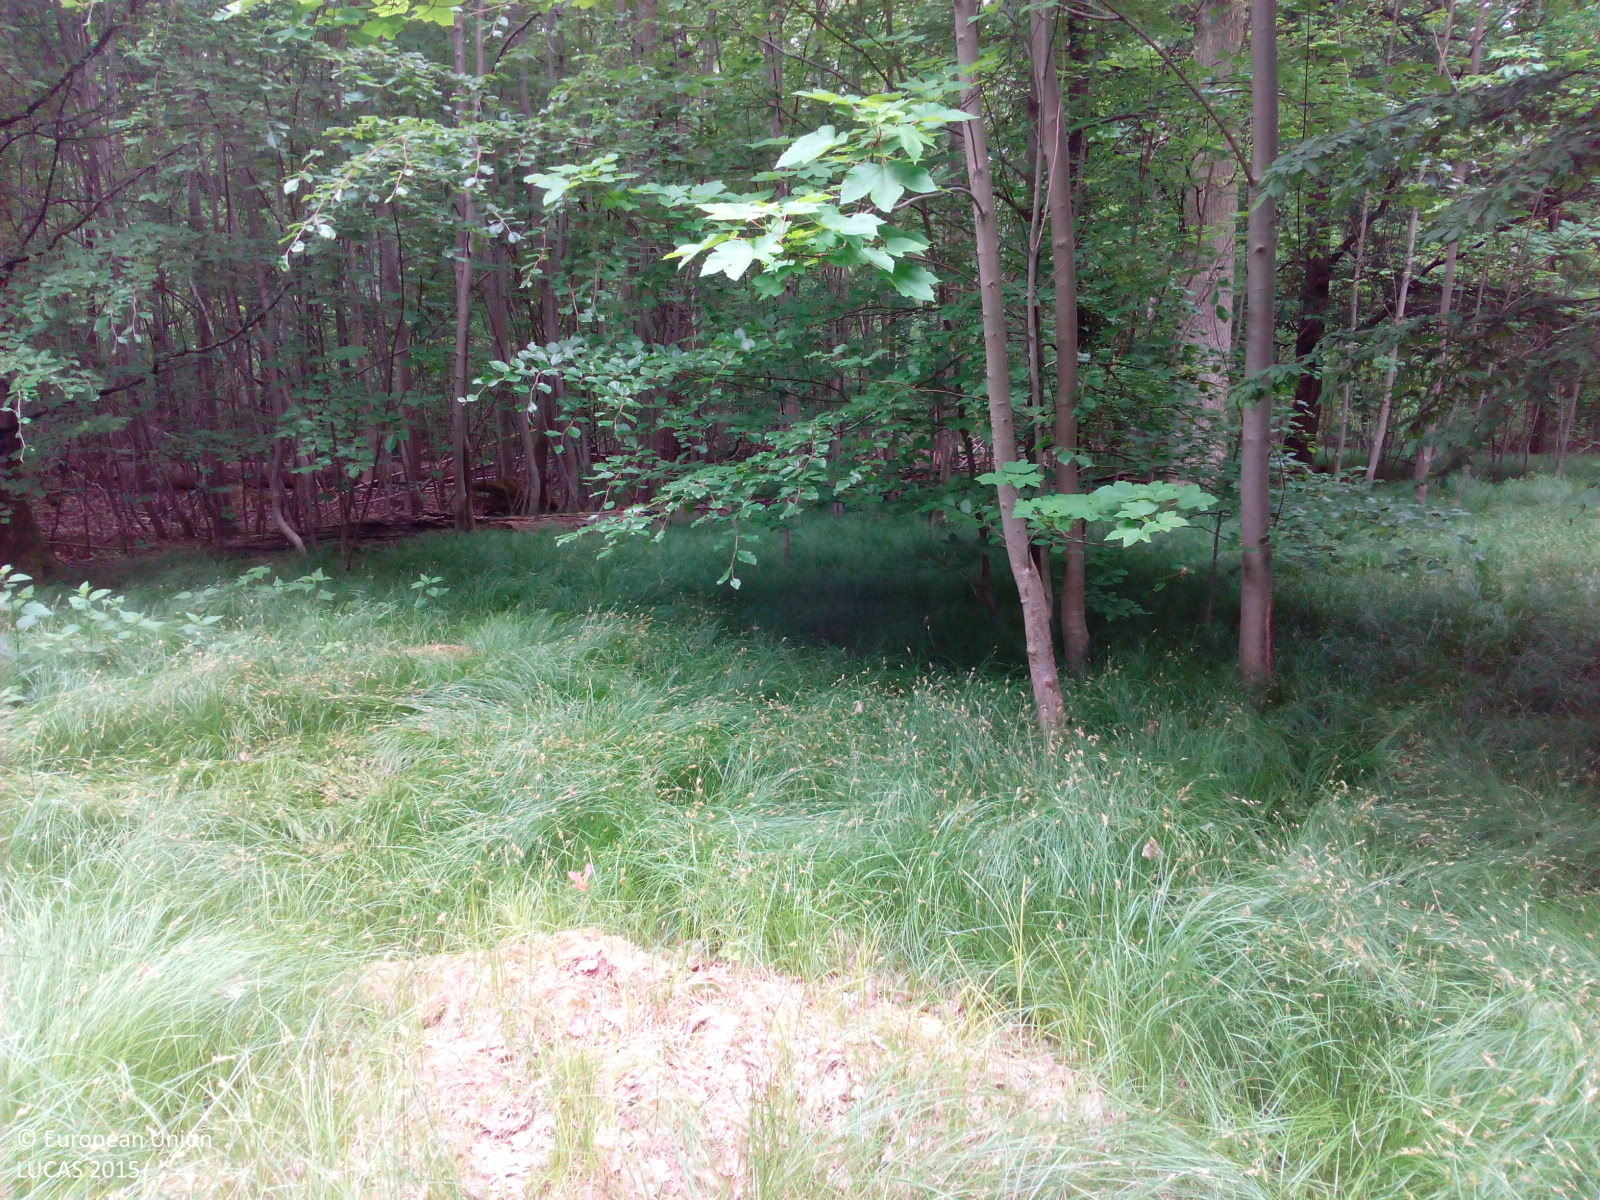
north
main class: Woodland
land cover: Broadleaved woodland
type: mesophytic deciduous forest
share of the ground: 25 - 50 %
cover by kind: herbaceous plants 55 %, broadleaved forest trees 40 %, shrubs 5 %
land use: Forestry
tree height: > 5 m
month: May
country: DE
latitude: 48.6712
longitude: 9.3078
